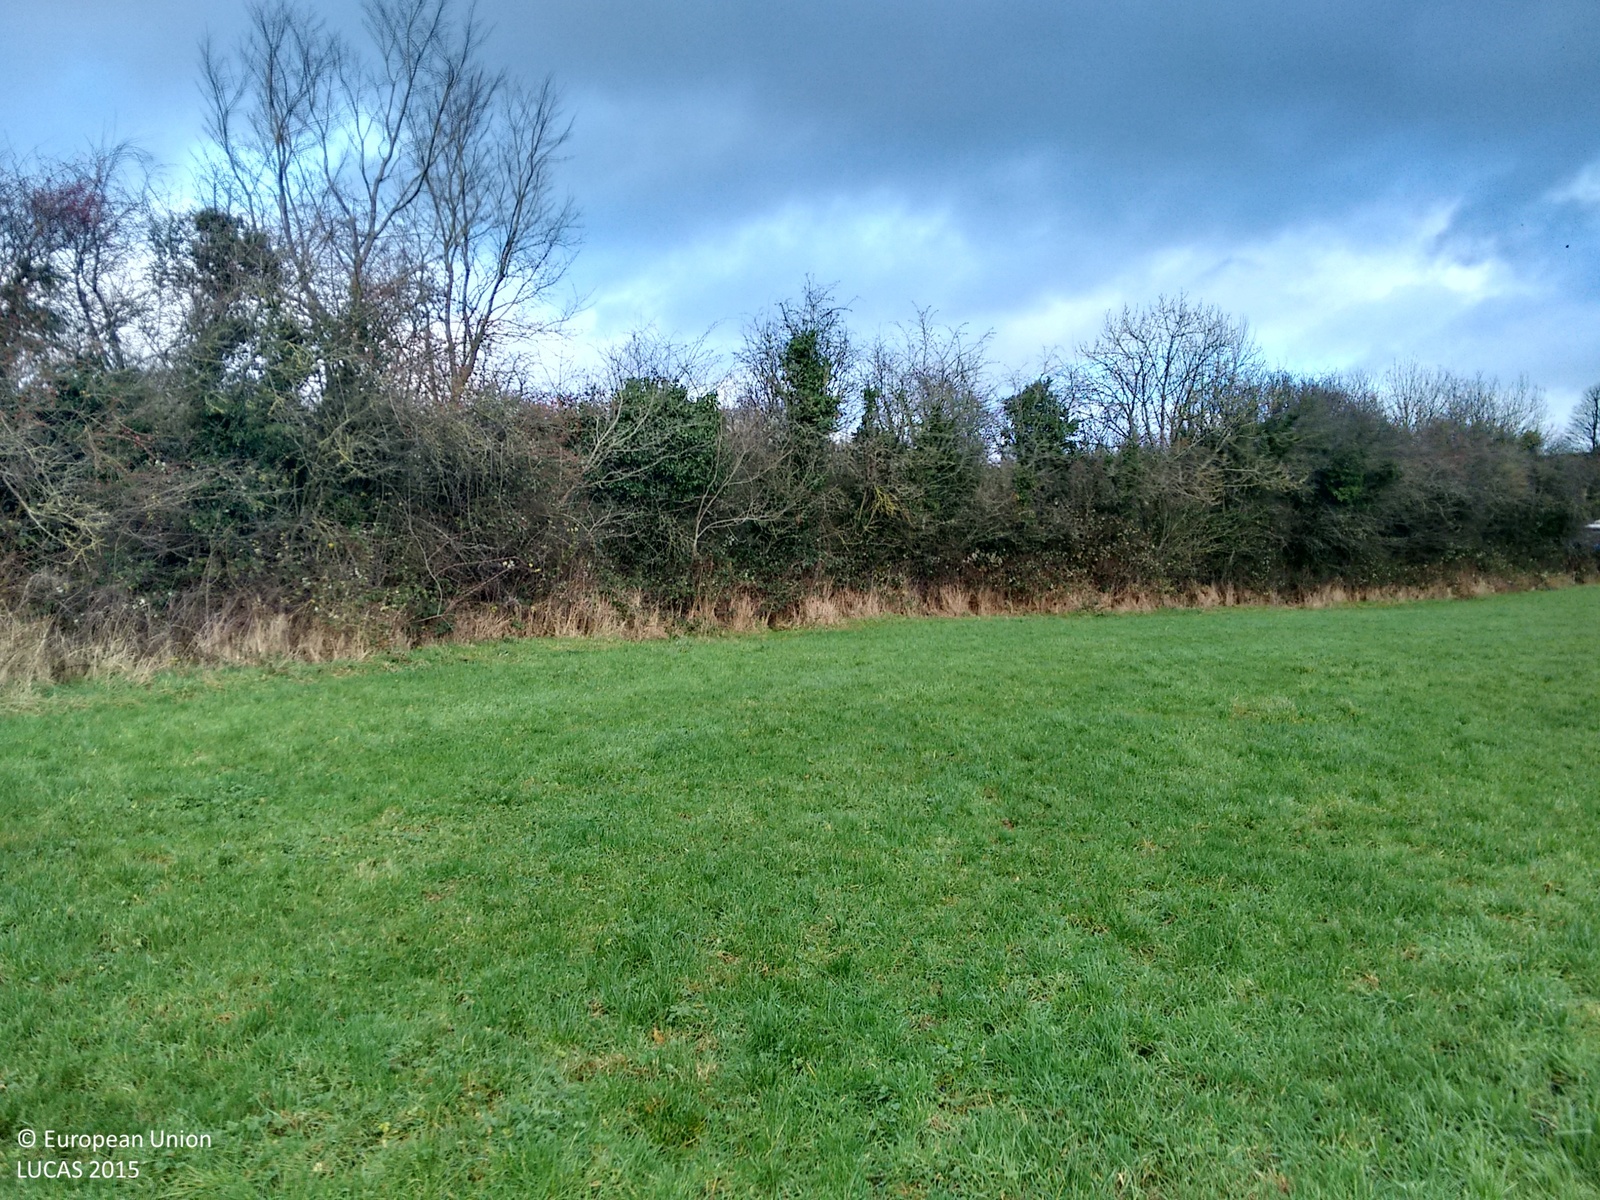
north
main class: Grassland
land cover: Grassland without tree/shrub cover
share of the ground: > 75 %
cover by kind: herbaceous plants 100 %
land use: Agriculture (excluding fallow land and kitchen gardens)
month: December
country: IE
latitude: 53.9201
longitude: -6.7138
